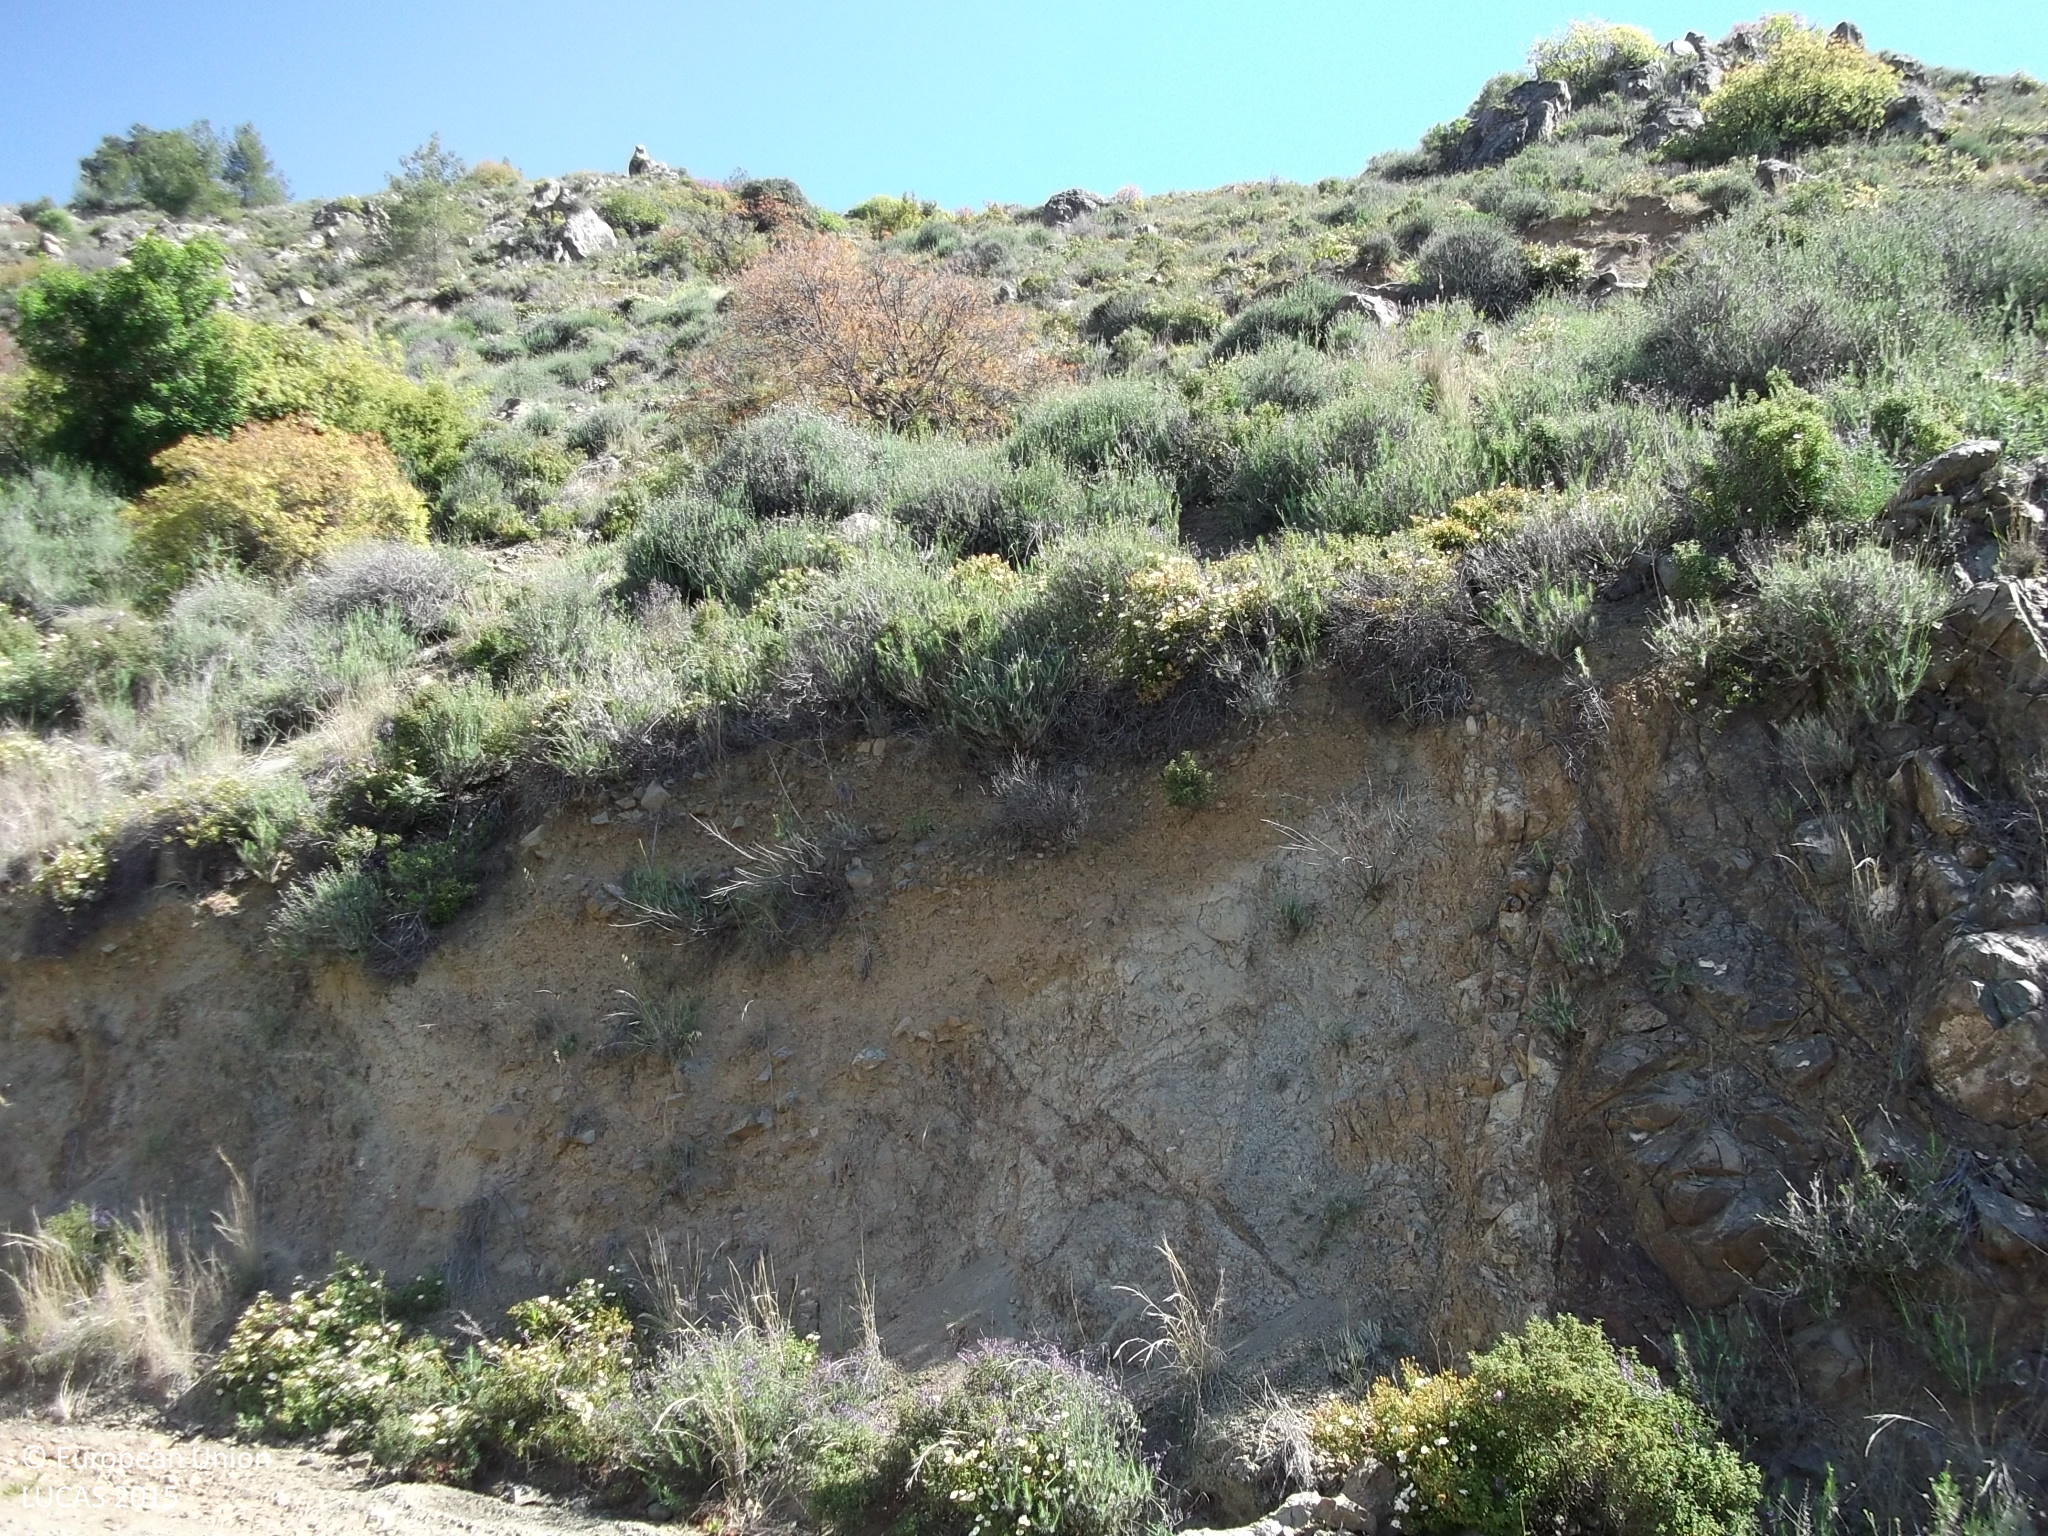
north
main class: Woodland
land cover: Pine dominated coniferous woodland
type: coniferous forest of the mediterranean region
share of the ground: 10 - 25 %
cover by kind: shrubs 45 %, consolidated bare surface 40 %, coniferous forest trees 15 %
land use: Forestry
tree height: > 5 m
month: April
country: CY
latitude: 34.8767
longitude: 33.1162
